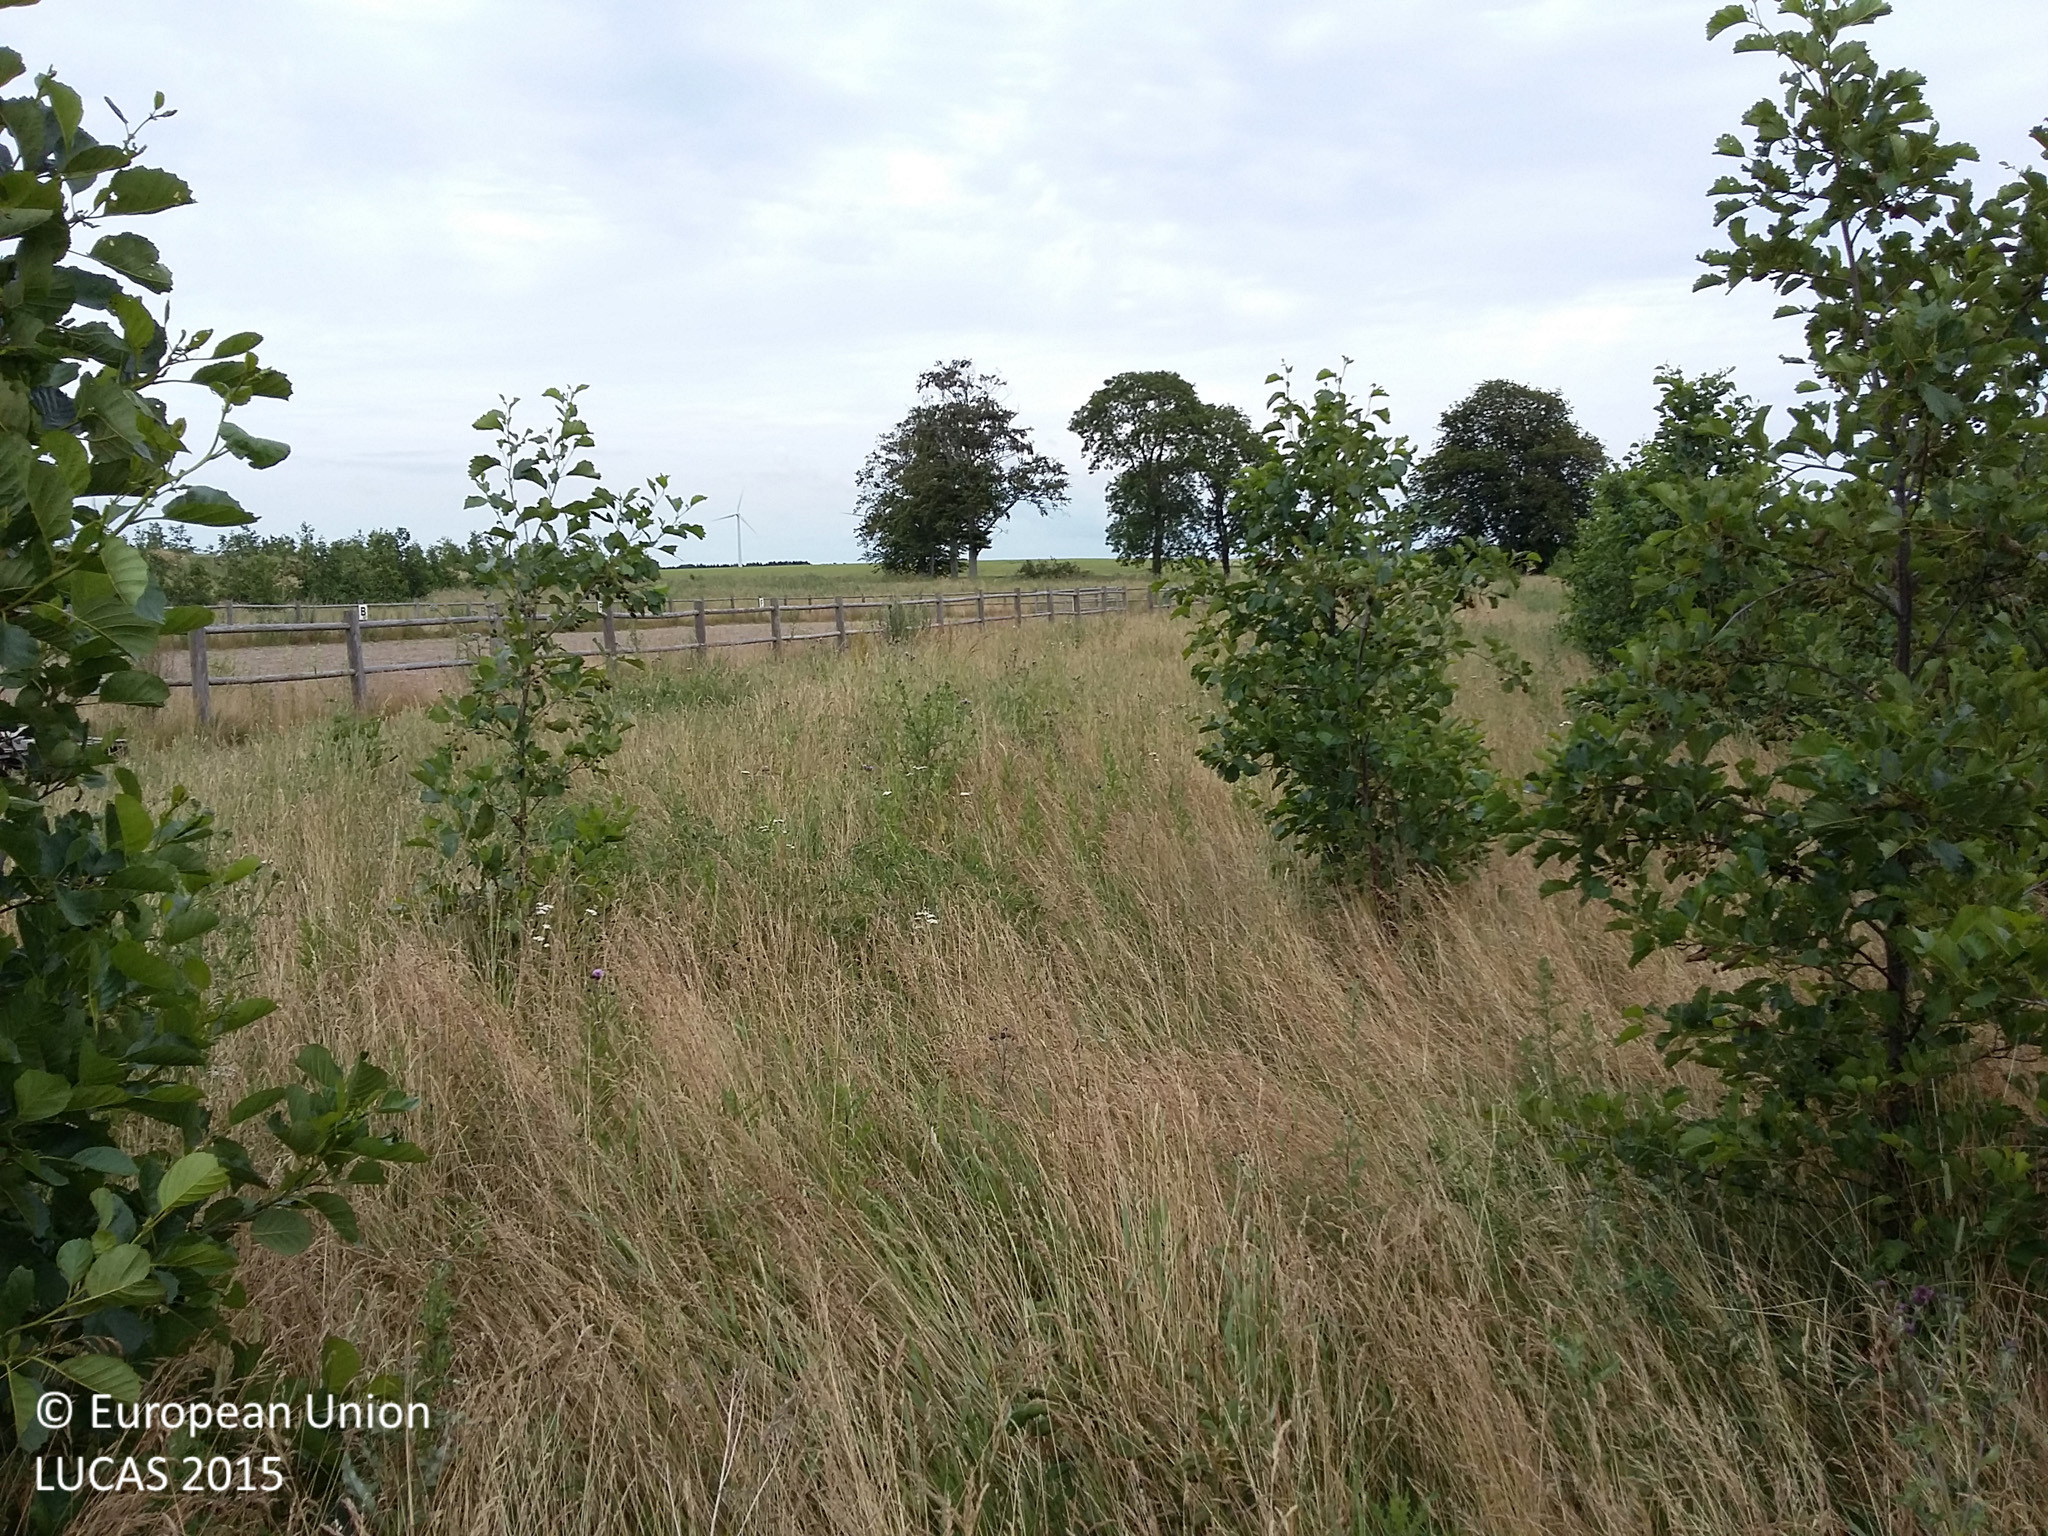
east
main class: Woodland
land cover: Broadleaved woodland
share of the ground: 25 - 50 %
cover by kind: herbaceous plants 65 %, broadleaved forest trees 35 %
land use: Agriculture (excluding fallow land and kitchen gardens)
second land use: Amenities, museums, leisure
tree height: < 5 m
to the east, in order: Broadleaved woodland; Grassland without tree/shrub cover; Tracks; Fences; Other bare soil; Fences; Spontaneously vegetated surfaces; Tracks; Temporary grasslands
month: July
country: DK
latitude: 55.5338
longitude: 11.3139
